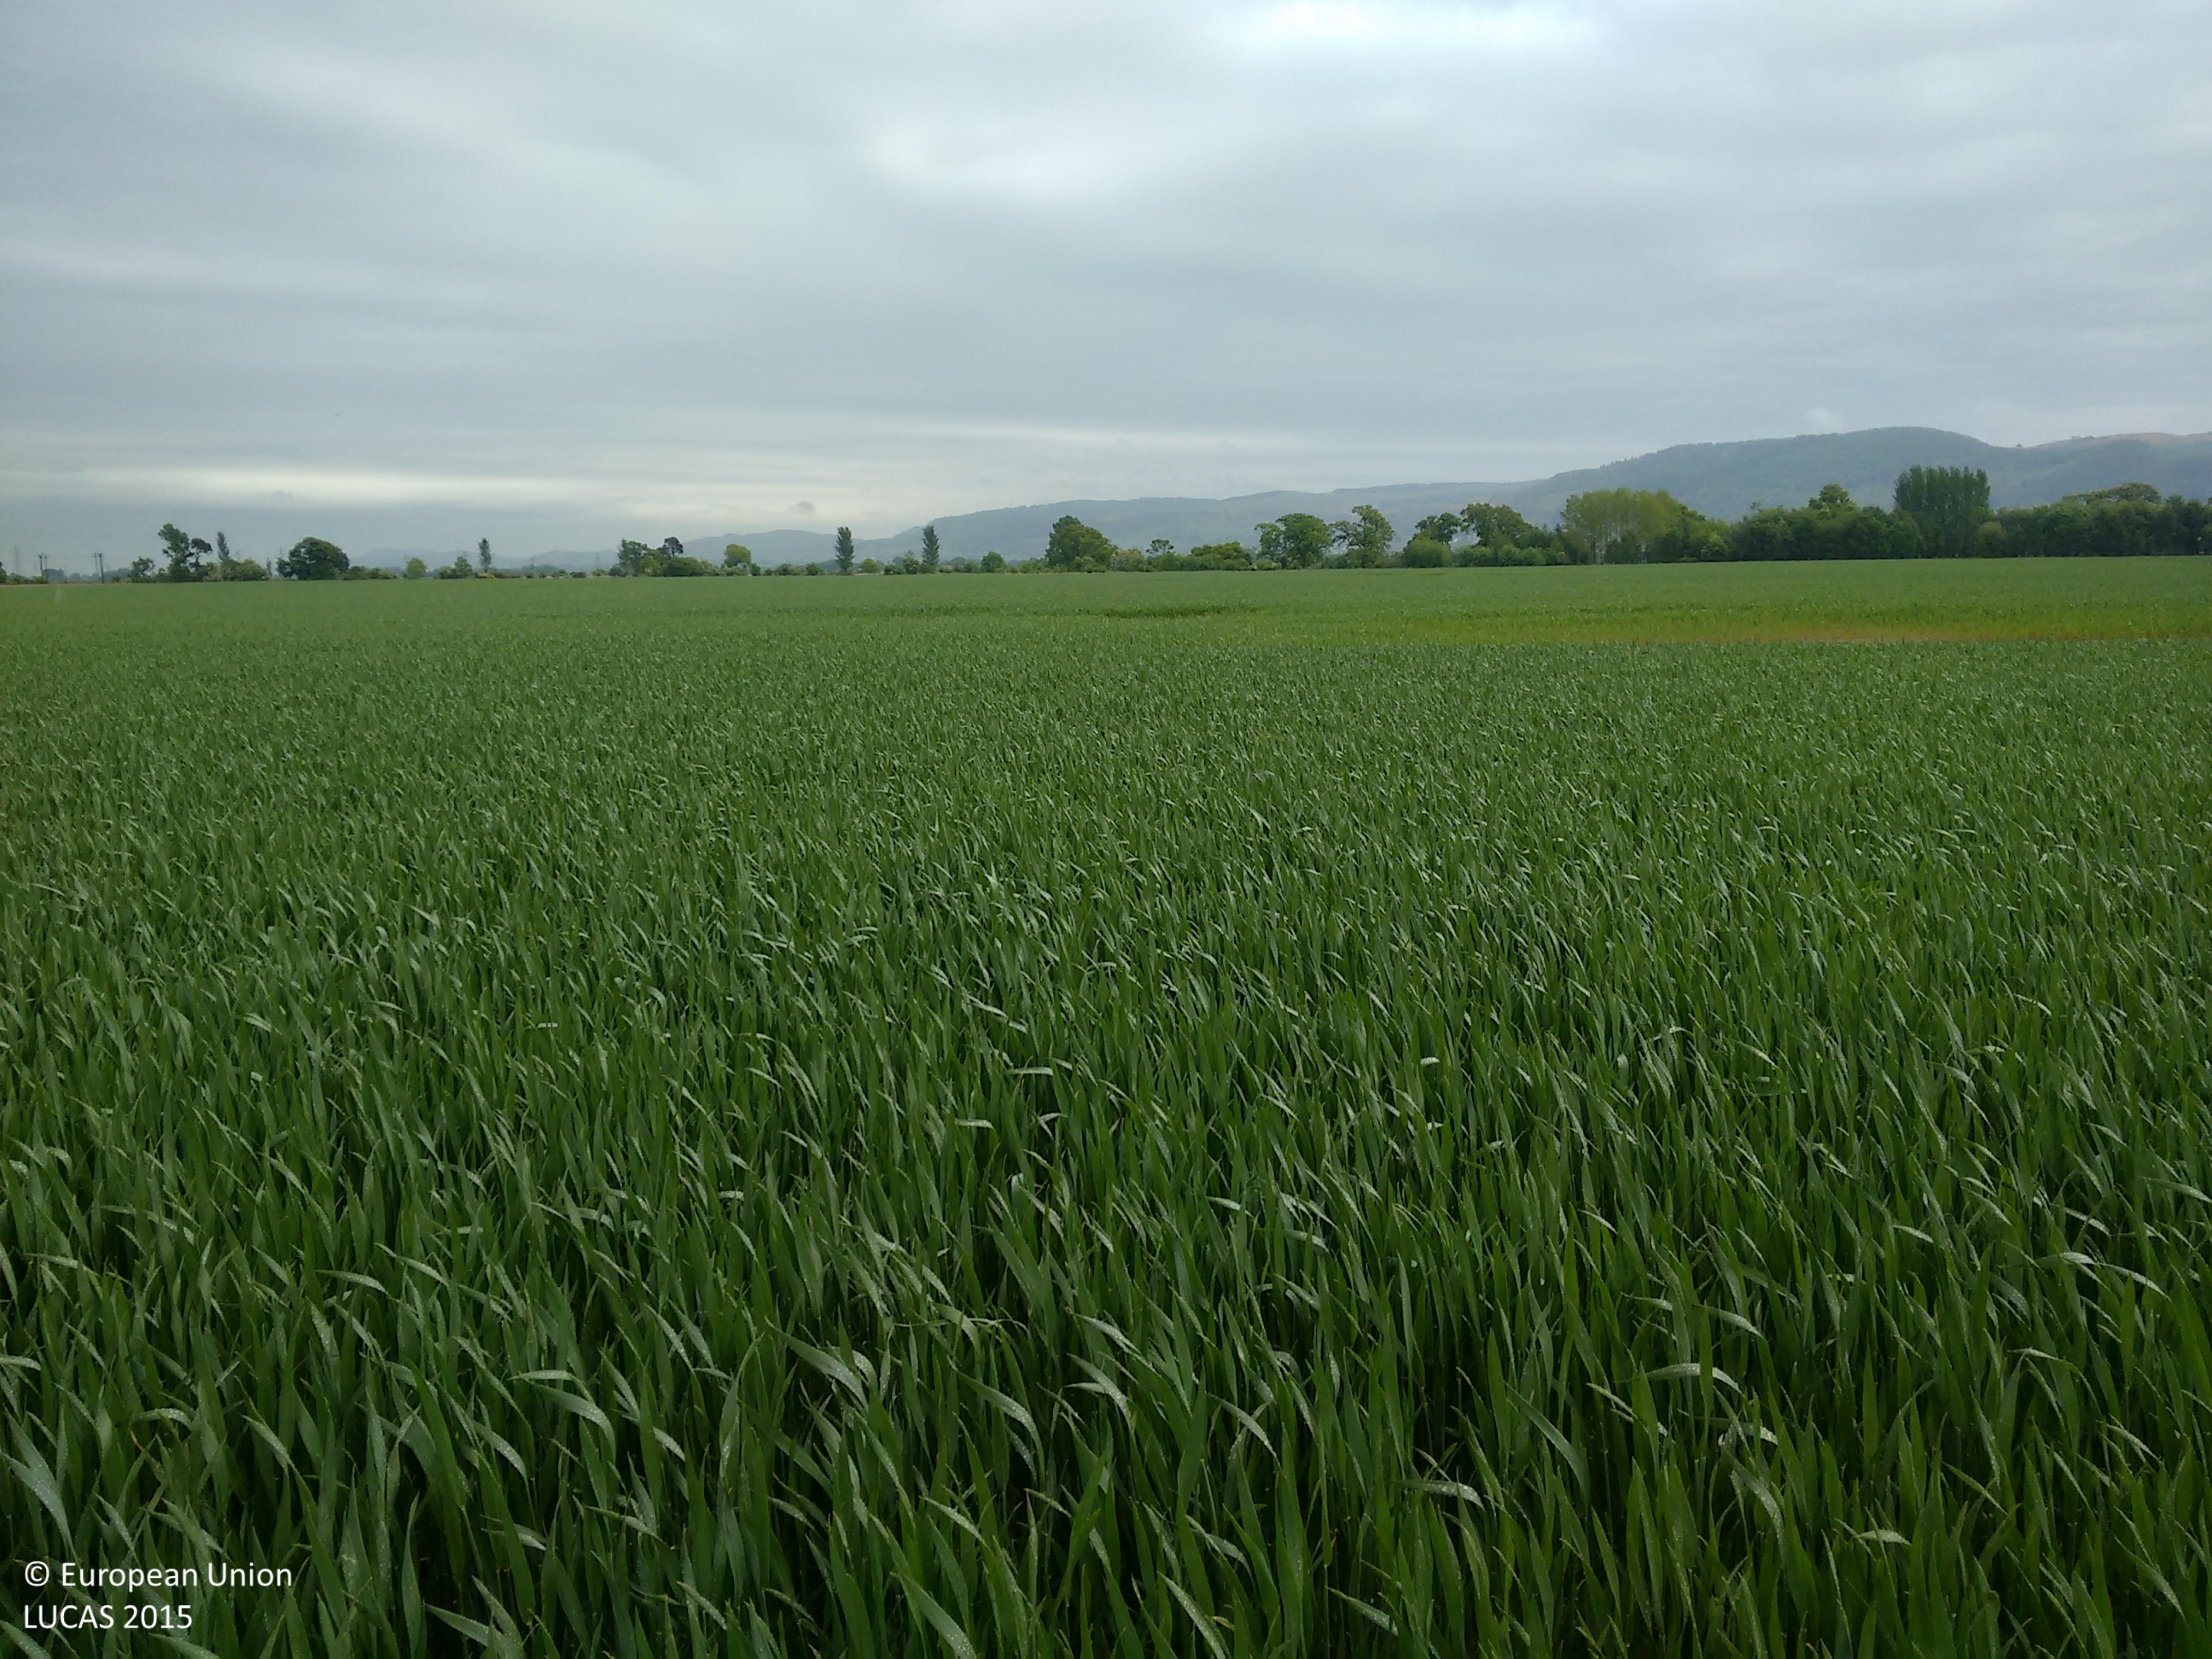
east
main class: Cropland
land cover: Common wheat
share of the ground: > 75 %
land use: Agriculture (excluding fallow land and kitchen gardens)
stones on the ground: < 10 %
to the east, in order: Common wheat
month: June
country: GB
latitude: 56.3401
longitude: -3.3875
